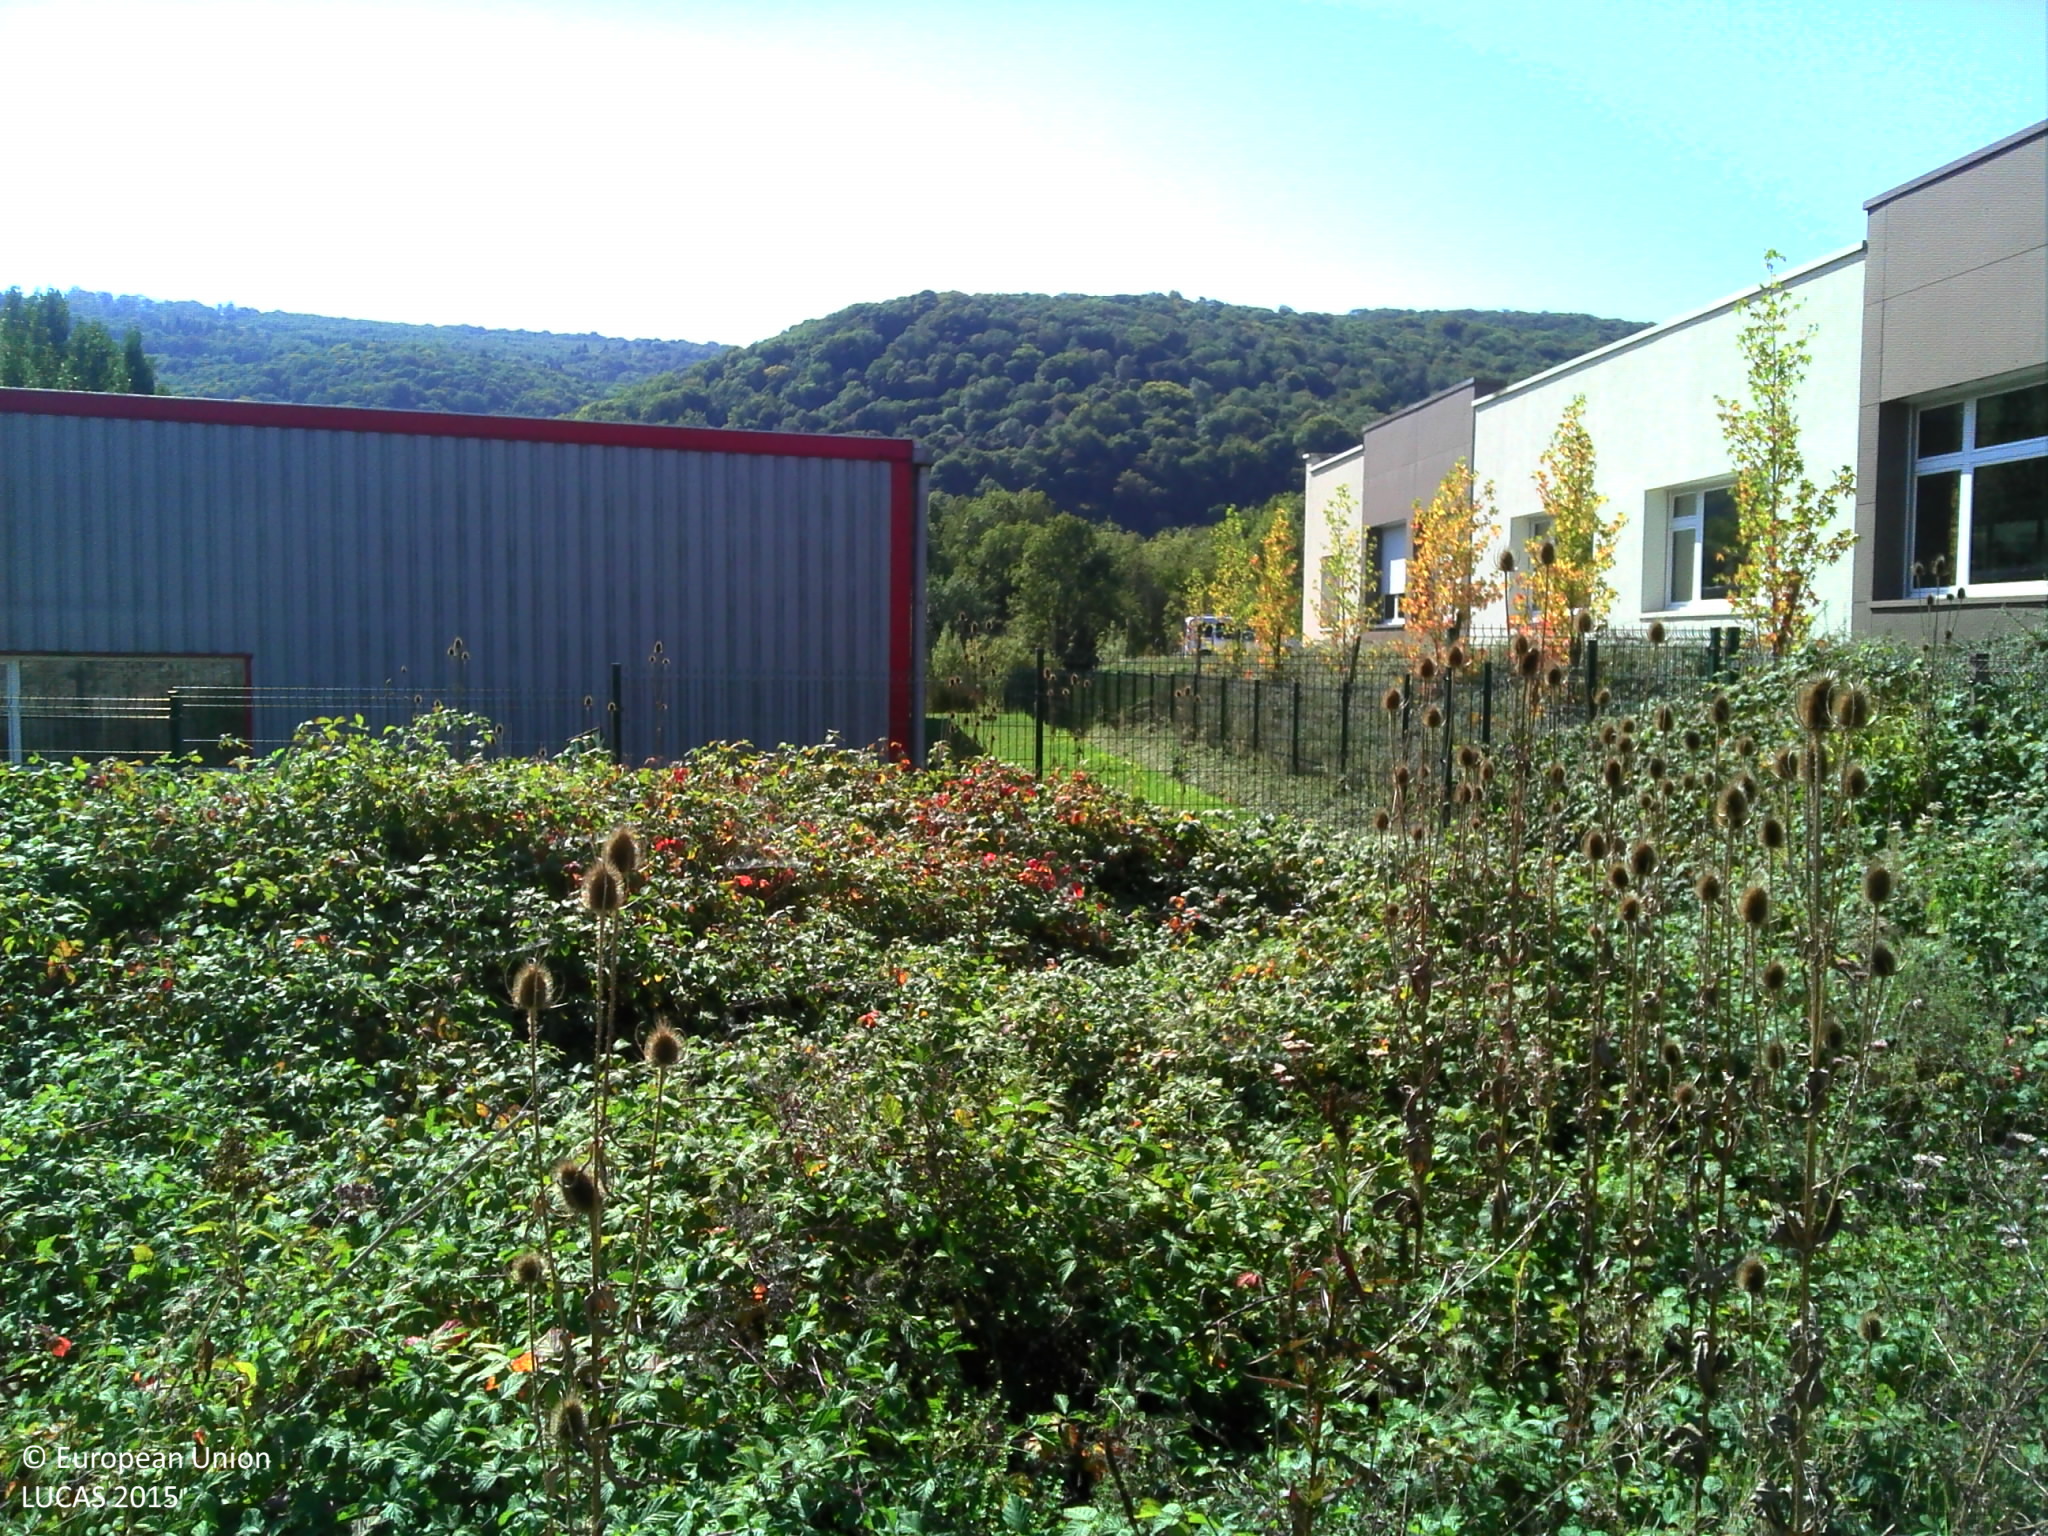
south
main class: Grassland
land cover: Spontaneously vegetated surfaces
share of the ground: > 75 %
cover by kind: herbaceous plants 95 %, shrubs 5 %
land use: Commerce
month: September
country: FR
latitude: 47.2717
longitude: 6.1024
